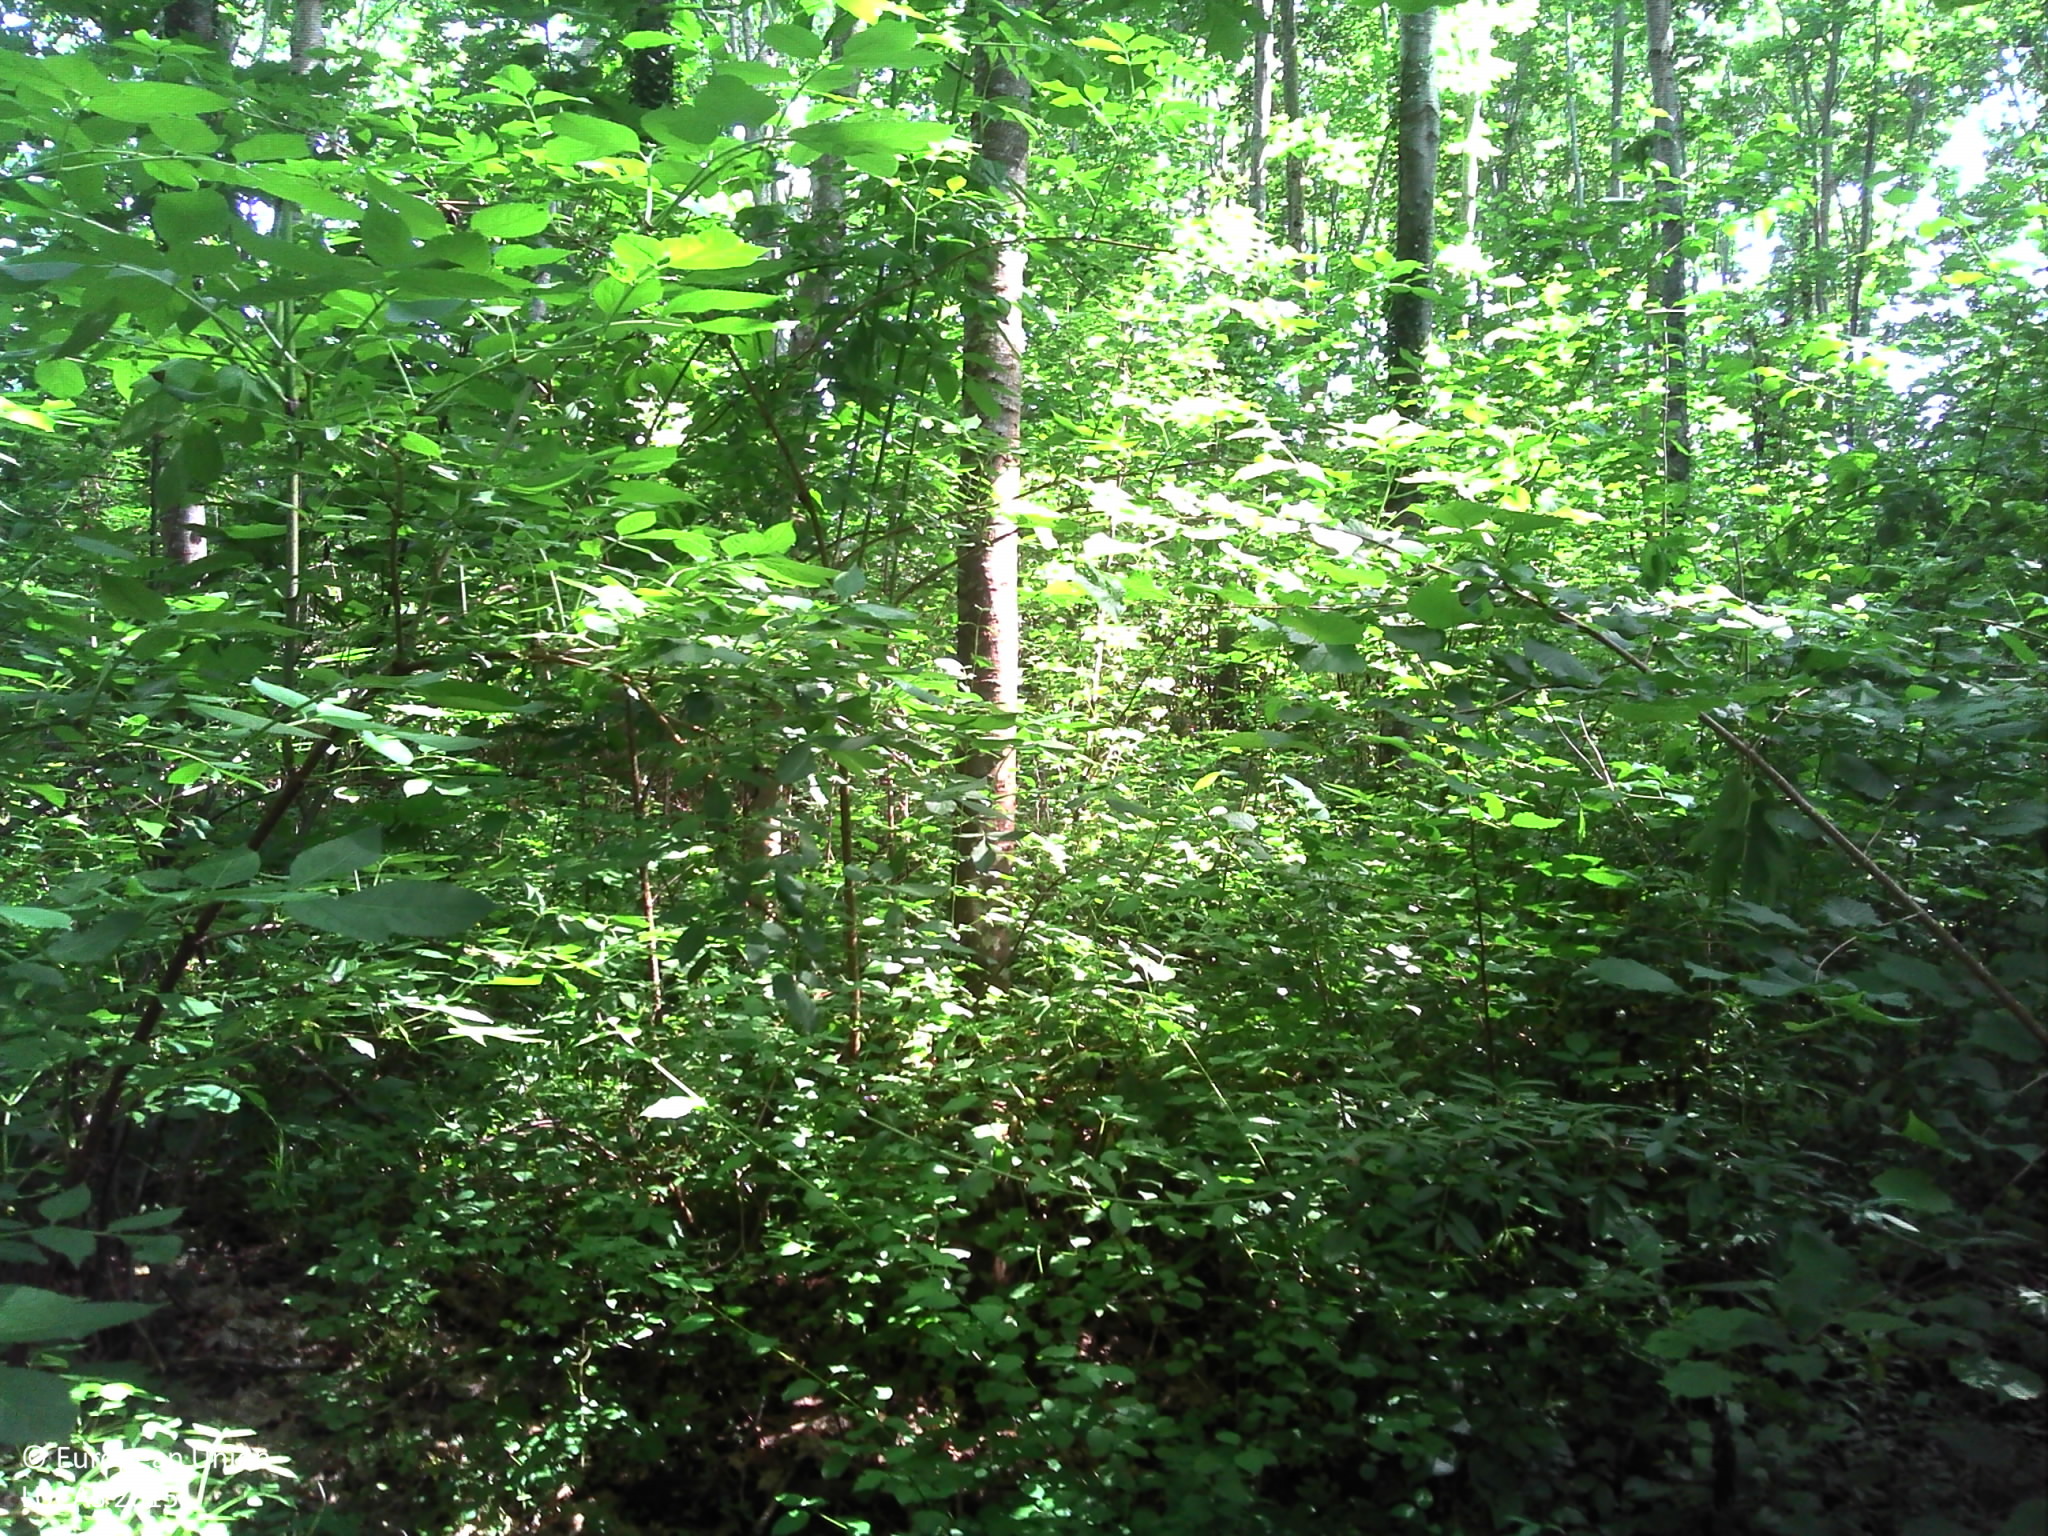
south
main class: Woodland
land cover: Broadleaved woodland
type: acidophilous oak and oak-birch forest
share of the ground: > 75 %
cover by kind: broadleaved forest trees 100 %
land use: Forestry
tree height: > 5 m
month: June
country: FR
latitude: 45.8704
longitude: 0.6727
